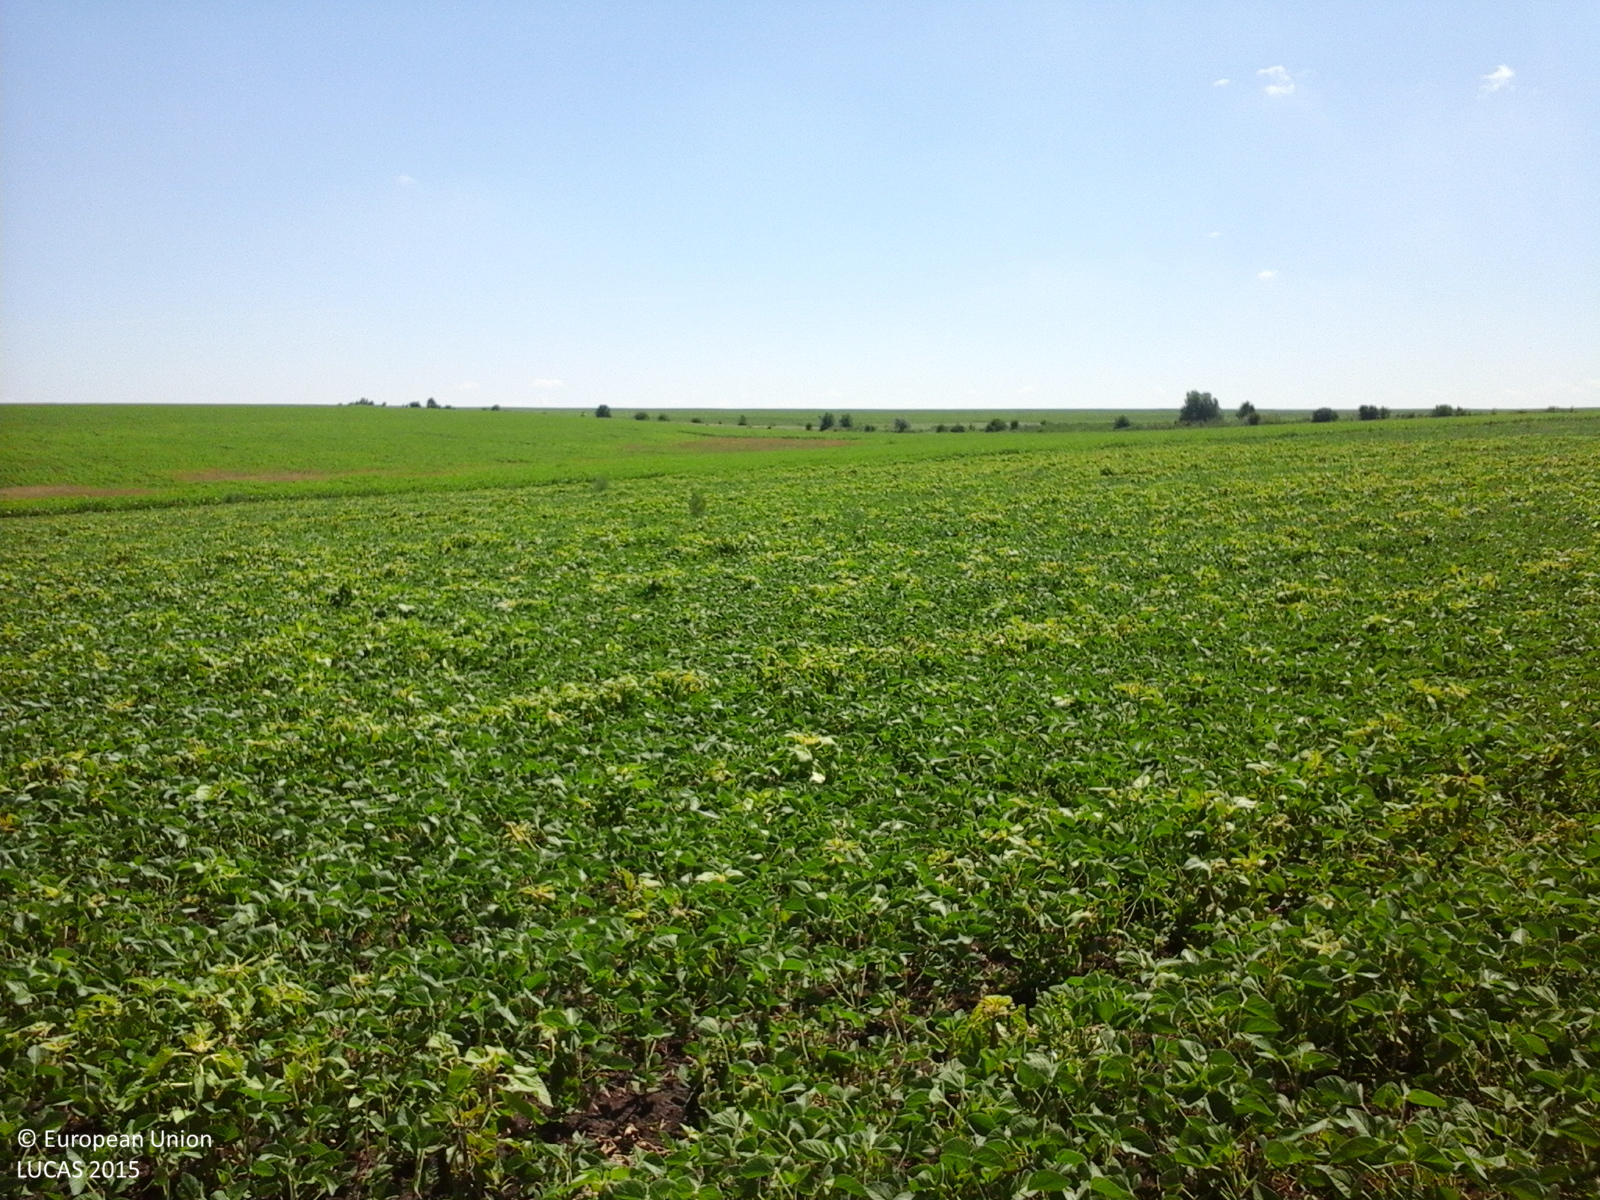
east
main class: Cropland
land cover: Soya
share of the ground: > 75 %
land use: Agriculture (excluding fallow land and kitchen gardens)
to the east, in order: Soya; Sunflower
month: June
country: RO
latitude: 47.8344
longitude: 26.8408
